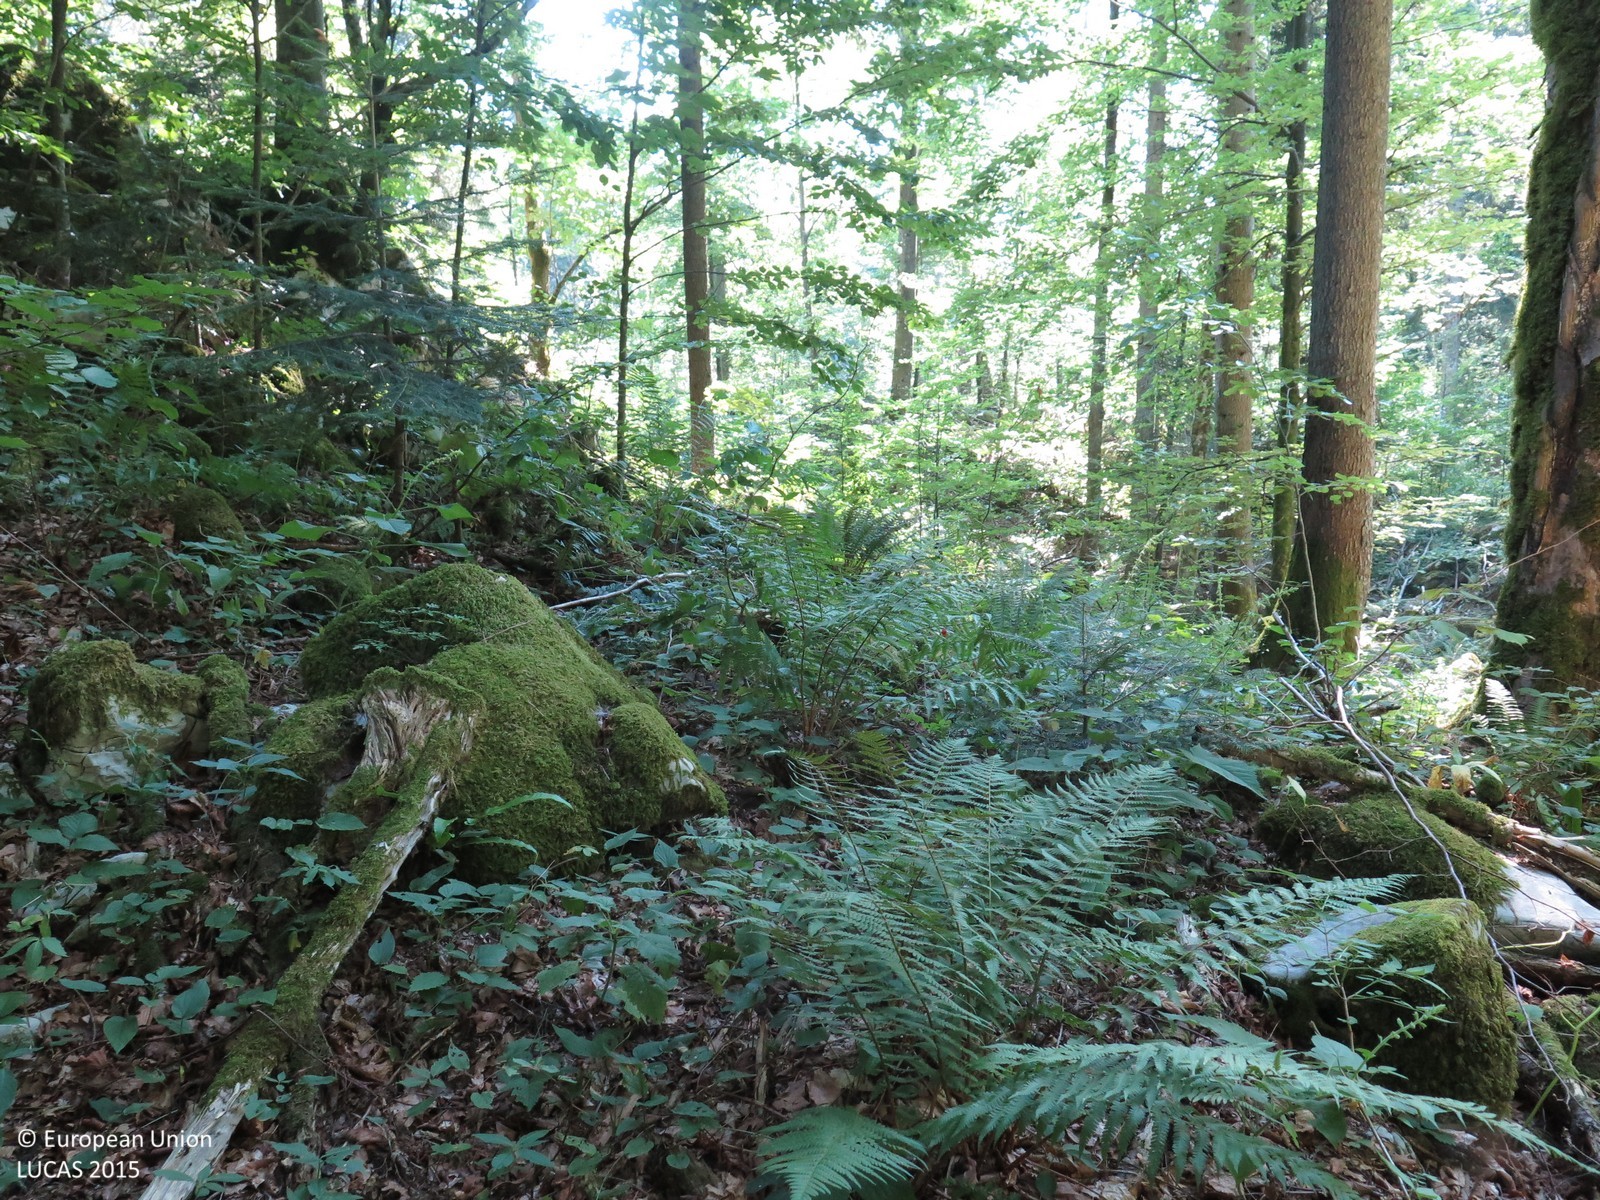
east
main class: Woodland
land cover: Other mixed woodland
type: beech forest
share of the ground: > 75 %
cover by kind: broadleaved forest trees 75 %, coniferous forest trees 25 %
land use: Forestry
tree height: > 5 m
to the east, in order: Other mixed woodland; Tracks; Other mixed woodland
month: August
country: HR
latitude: 45.4188
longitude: 15.0689
